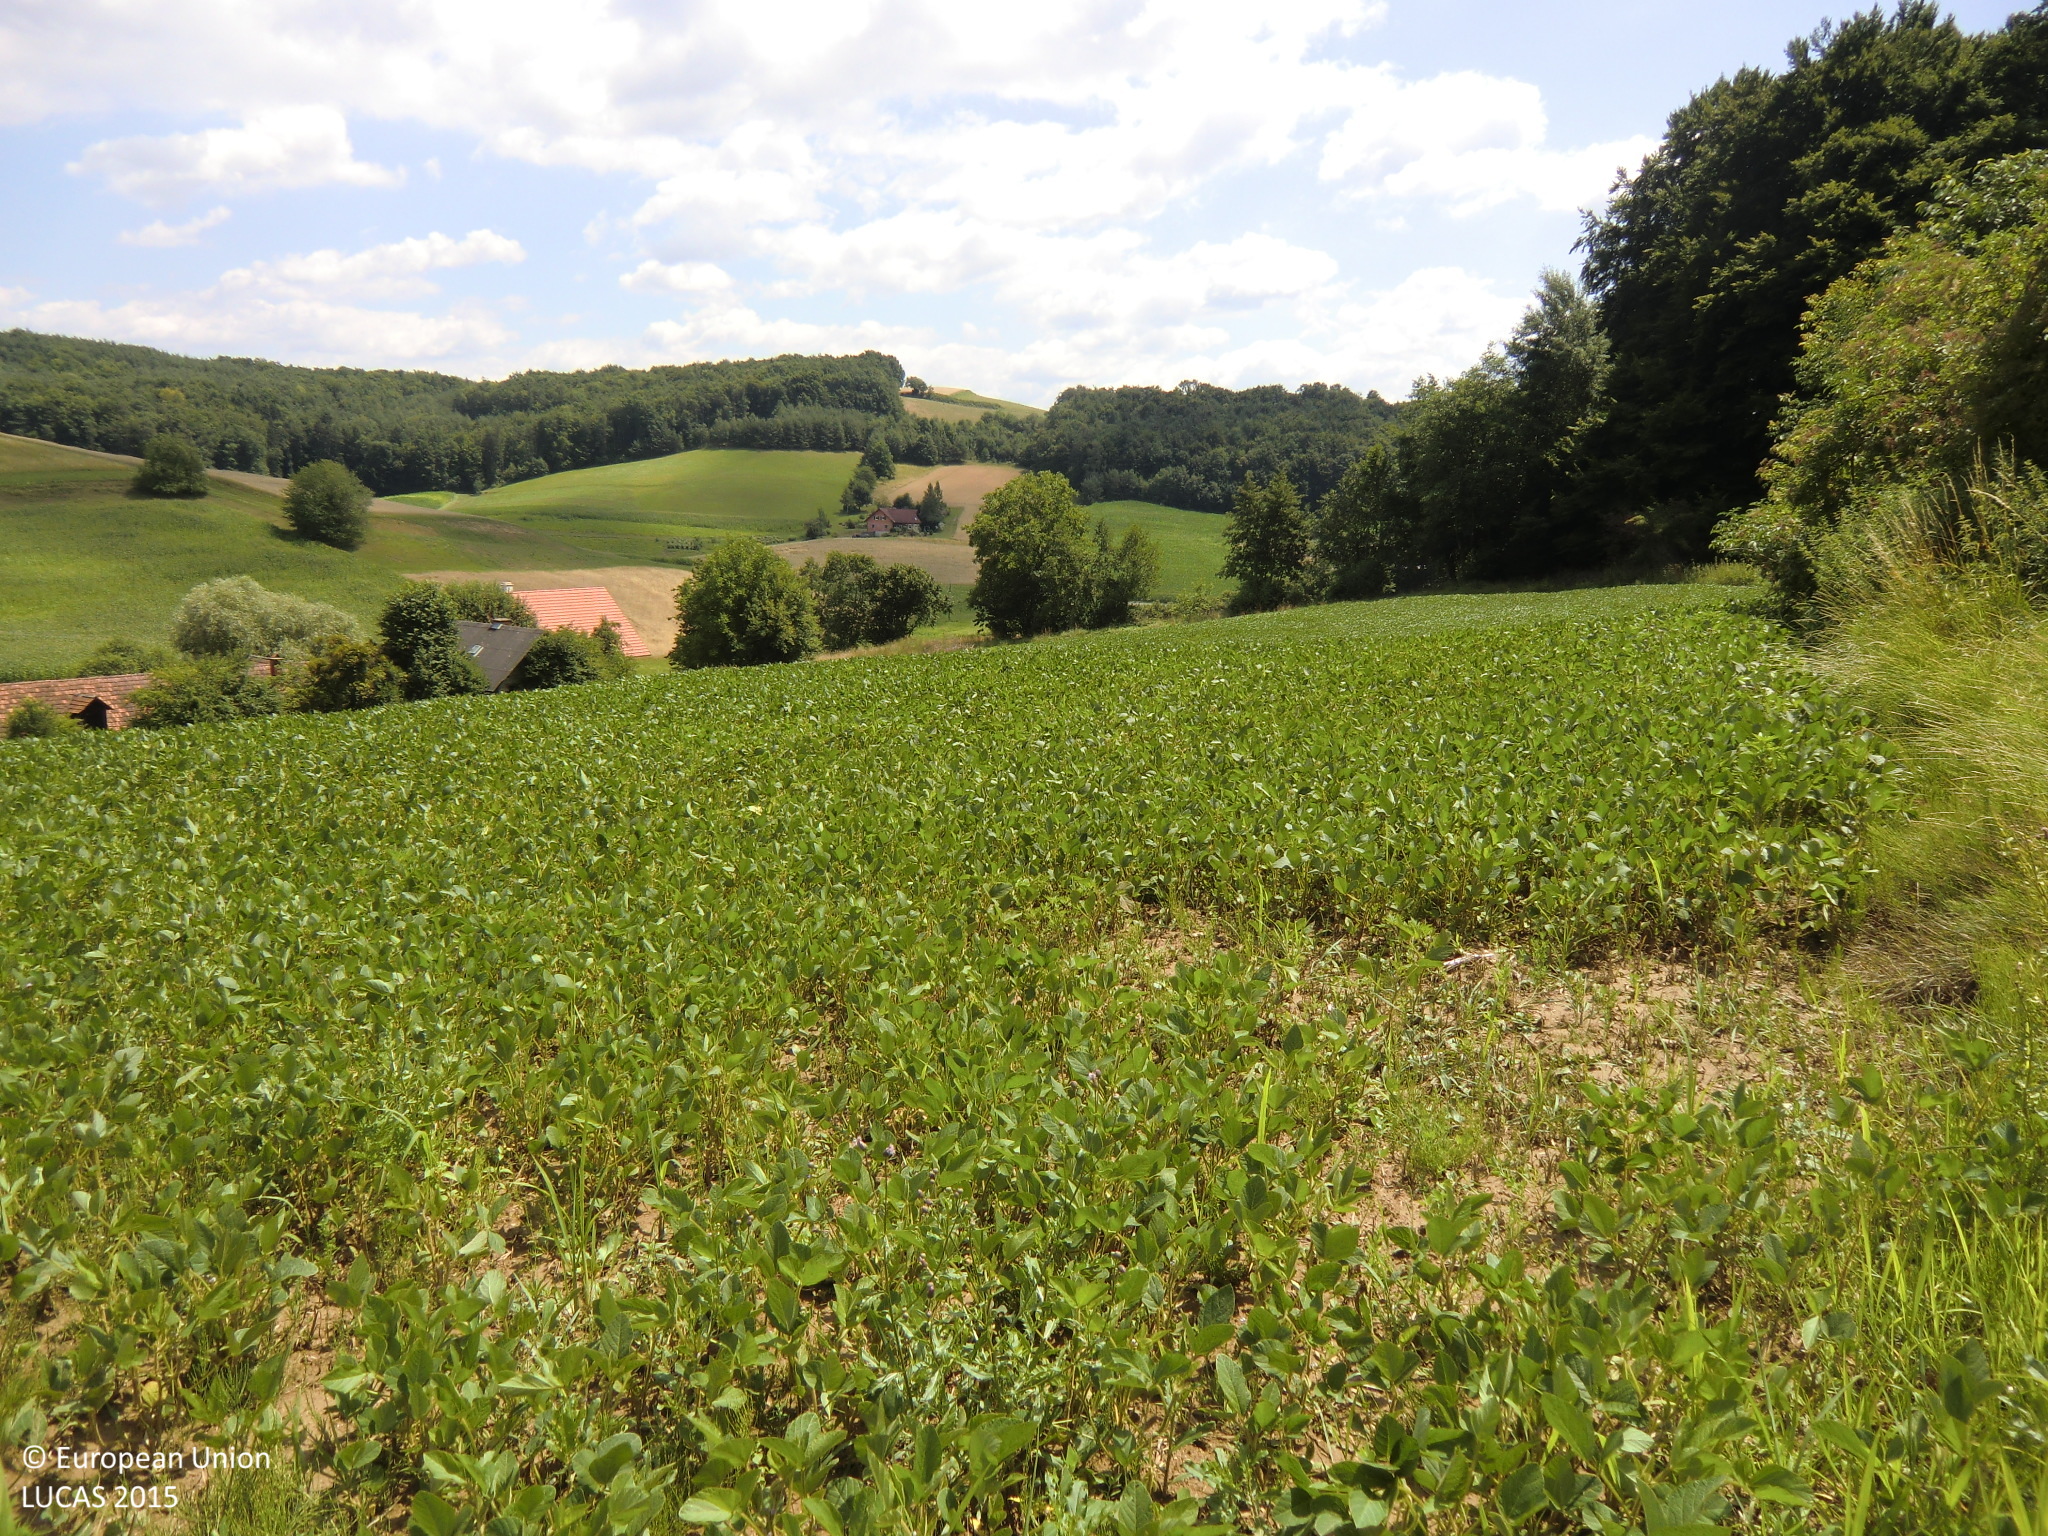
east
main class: Cropland
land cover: Barley
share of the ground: > 75 %
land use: Agriculture (excluding fallow land and kitchen gardens)
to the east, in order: Barley; Ditches and canals; Abandoned hedges; Soya; Single bushes/trees; Artificial constructions in urban areas; Grassland without tree/shrub cover; Paved roads, cycling and walking lanes; Grassland without tree/shrub cover; Ditches and canals; Grassland without tree/shrub cover; Electric lines; Grassland without tree/shrub cover
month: July
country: AT
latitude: 46.9724
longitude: 16.0870
